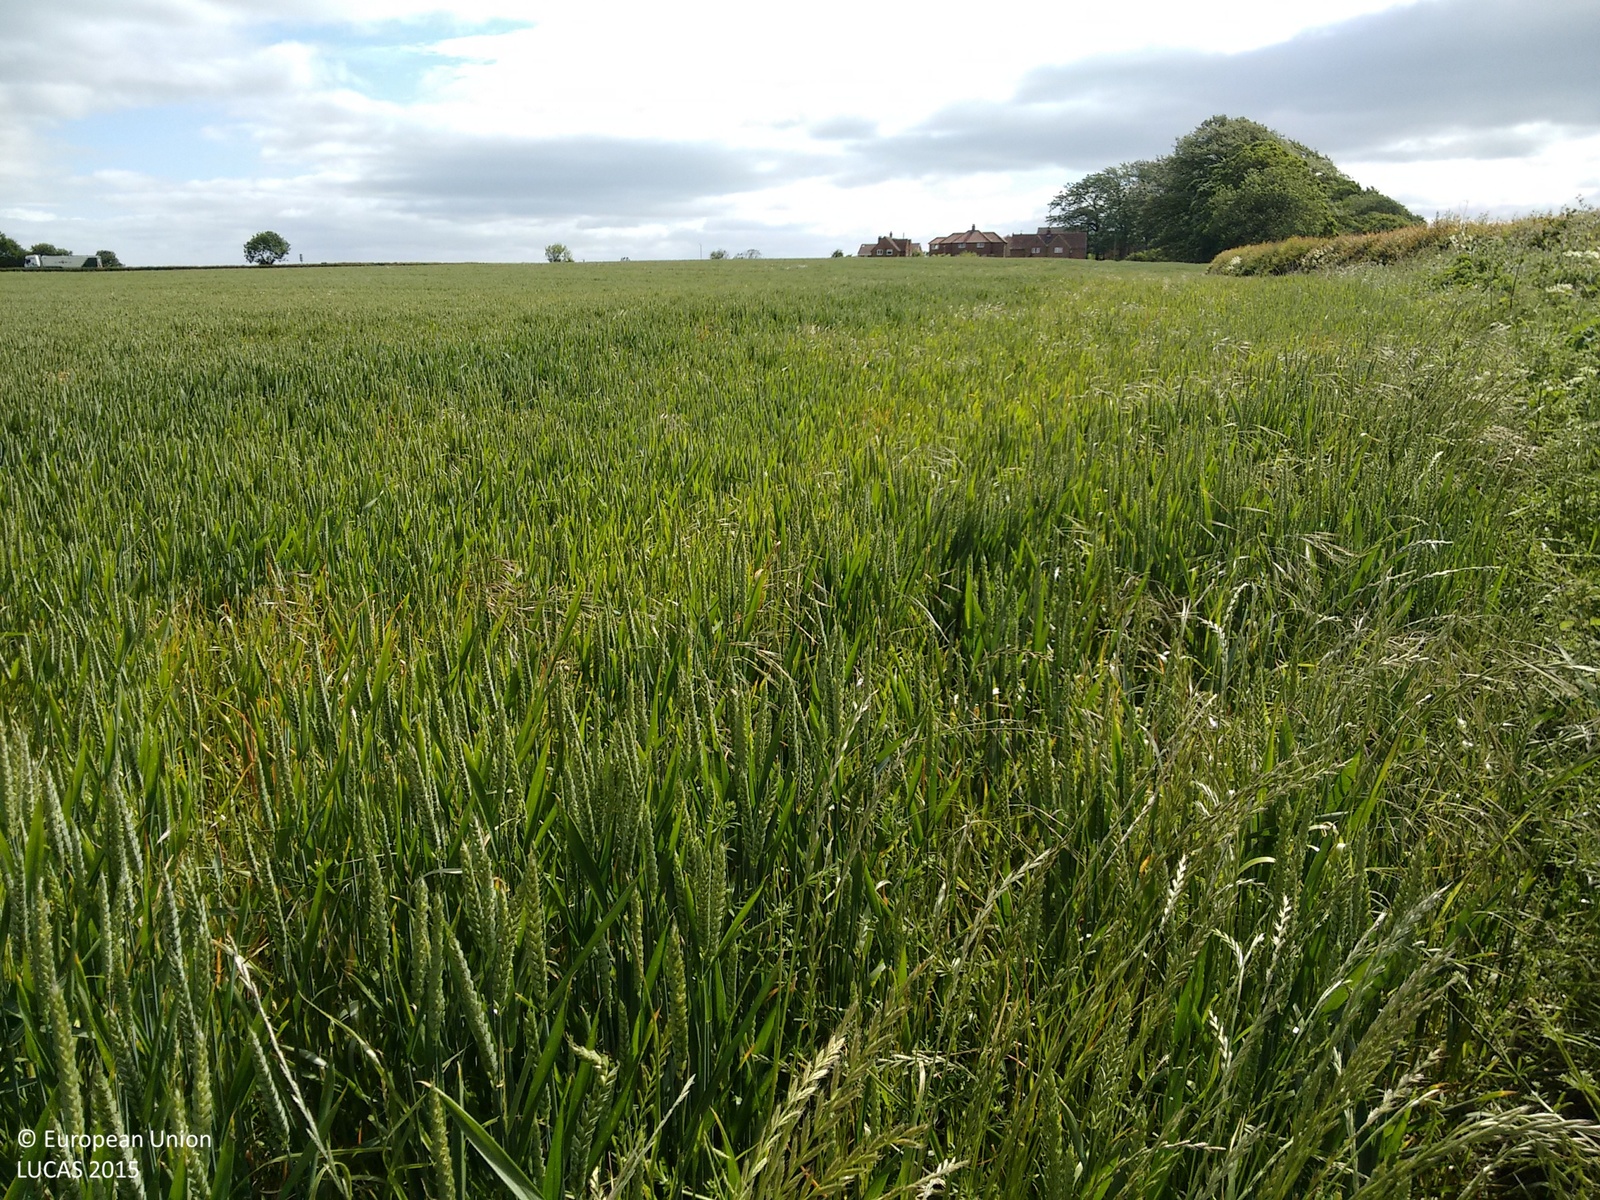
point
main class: Cropland
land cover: Common wheat
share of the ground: > 75 %
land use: Agriculture (excluding fallow land and kitchen gardens)
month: June
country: GB
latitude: 54.4354
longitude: -1.4722
